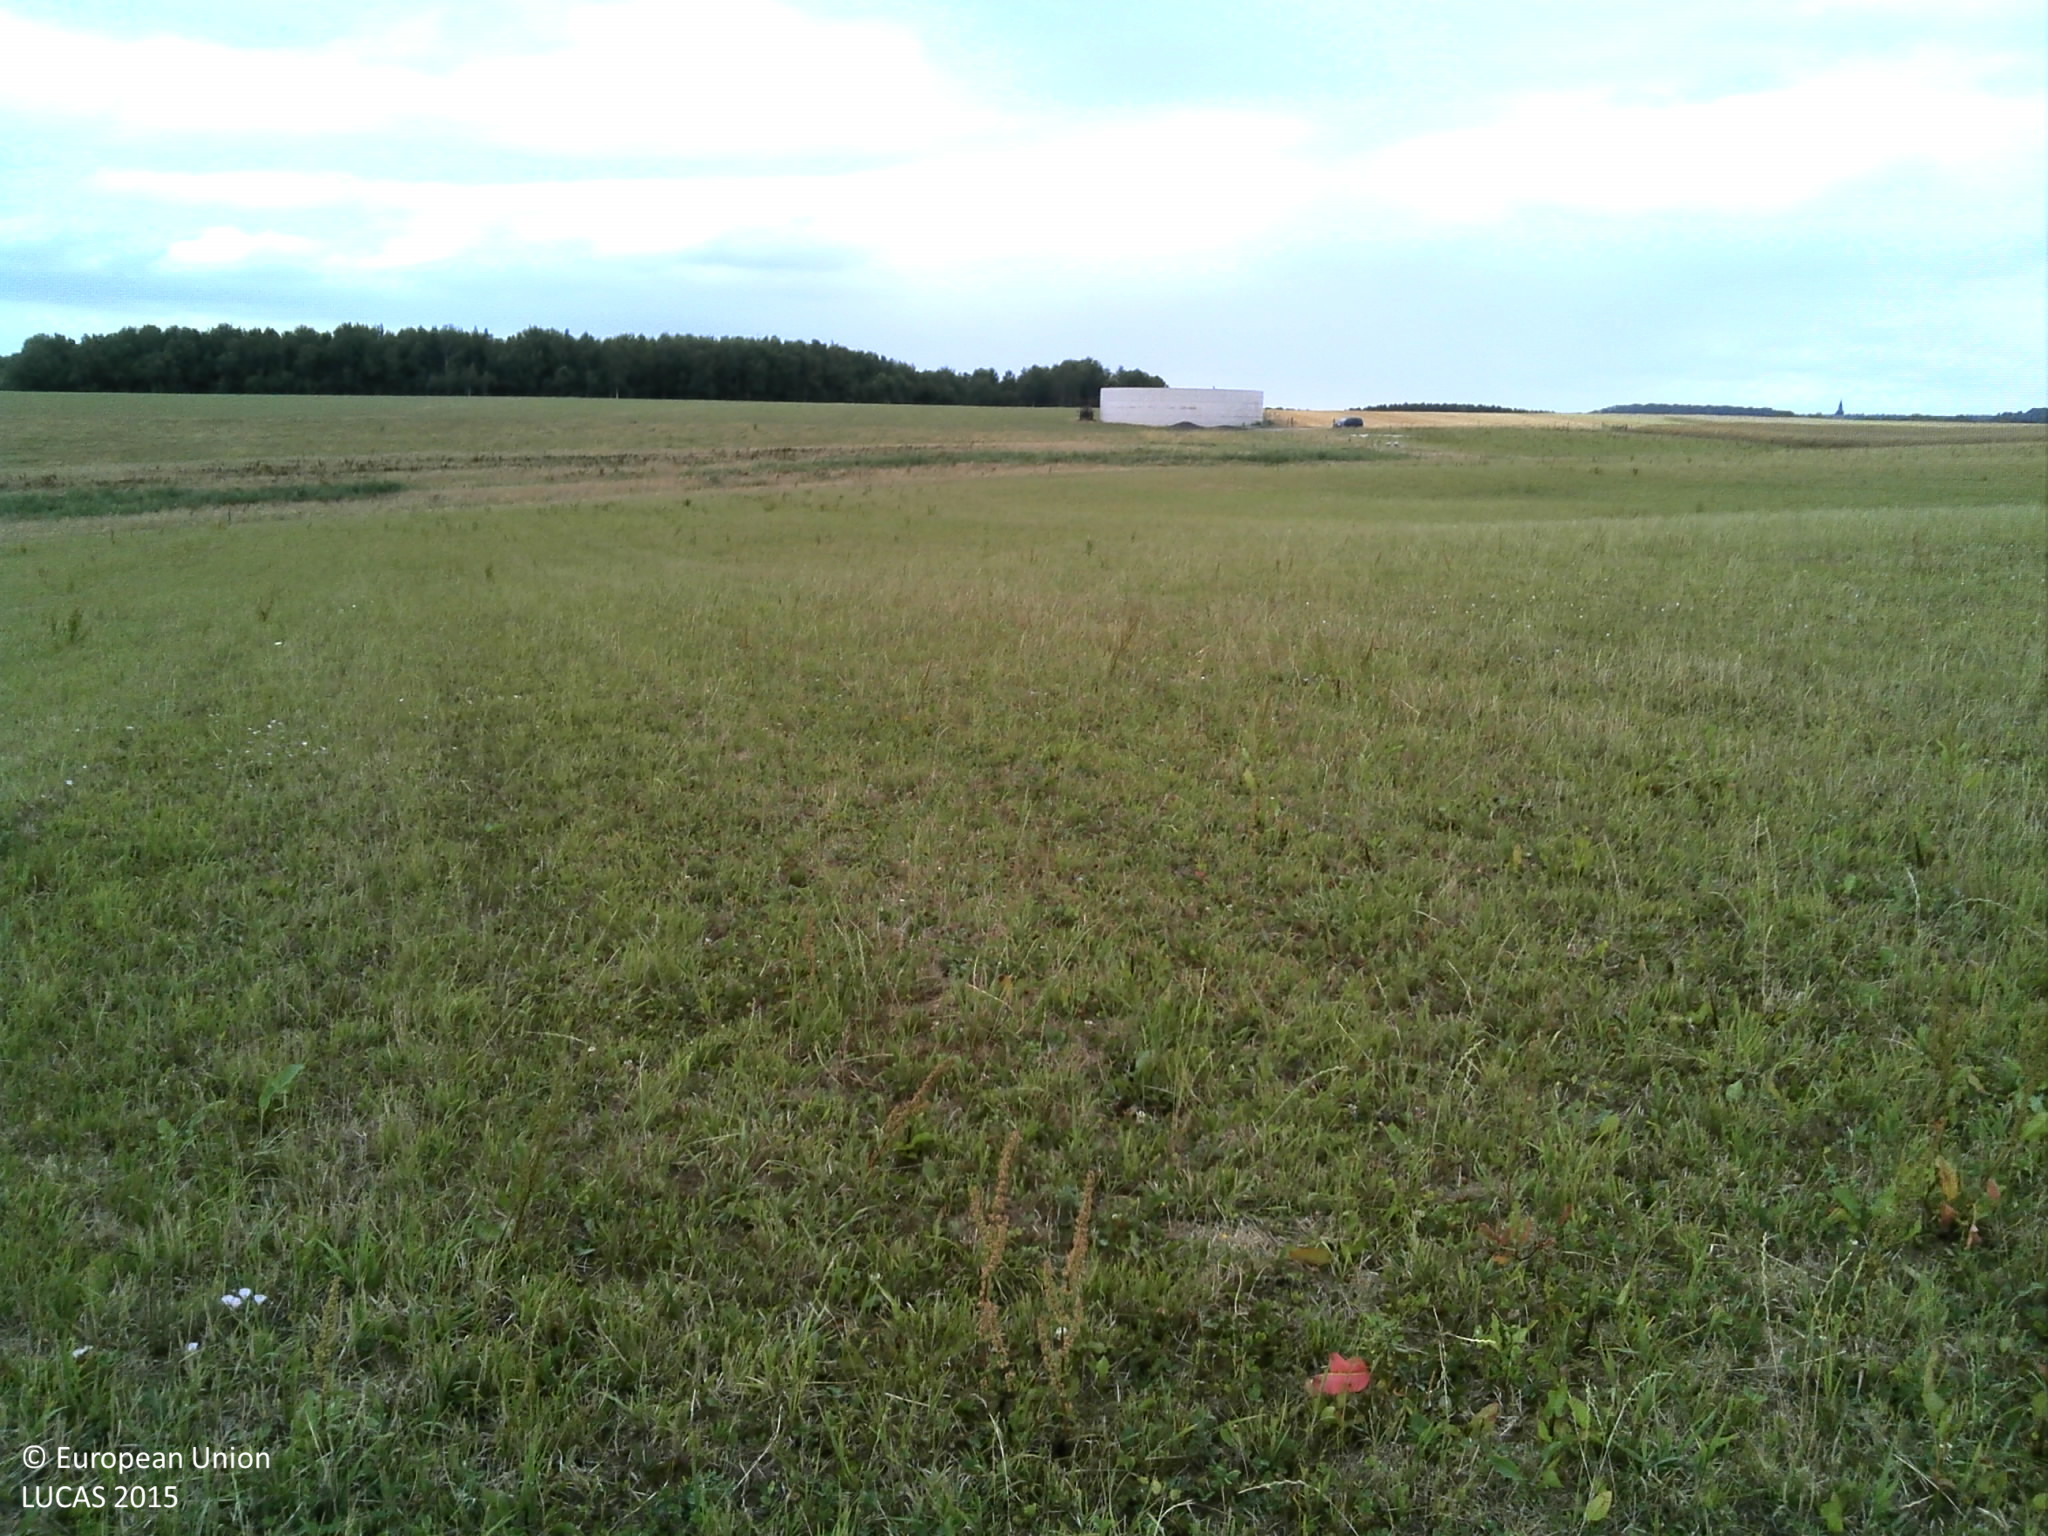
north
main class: Grassland
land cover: Grassland without tree/shrub cover
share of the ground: > 75 %
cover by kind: herbaceous plants 100 %
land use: Agriculture (excluding fallow land and kitchen gardens)
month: July
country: FR
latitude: 49.2221
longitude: 4.8761
